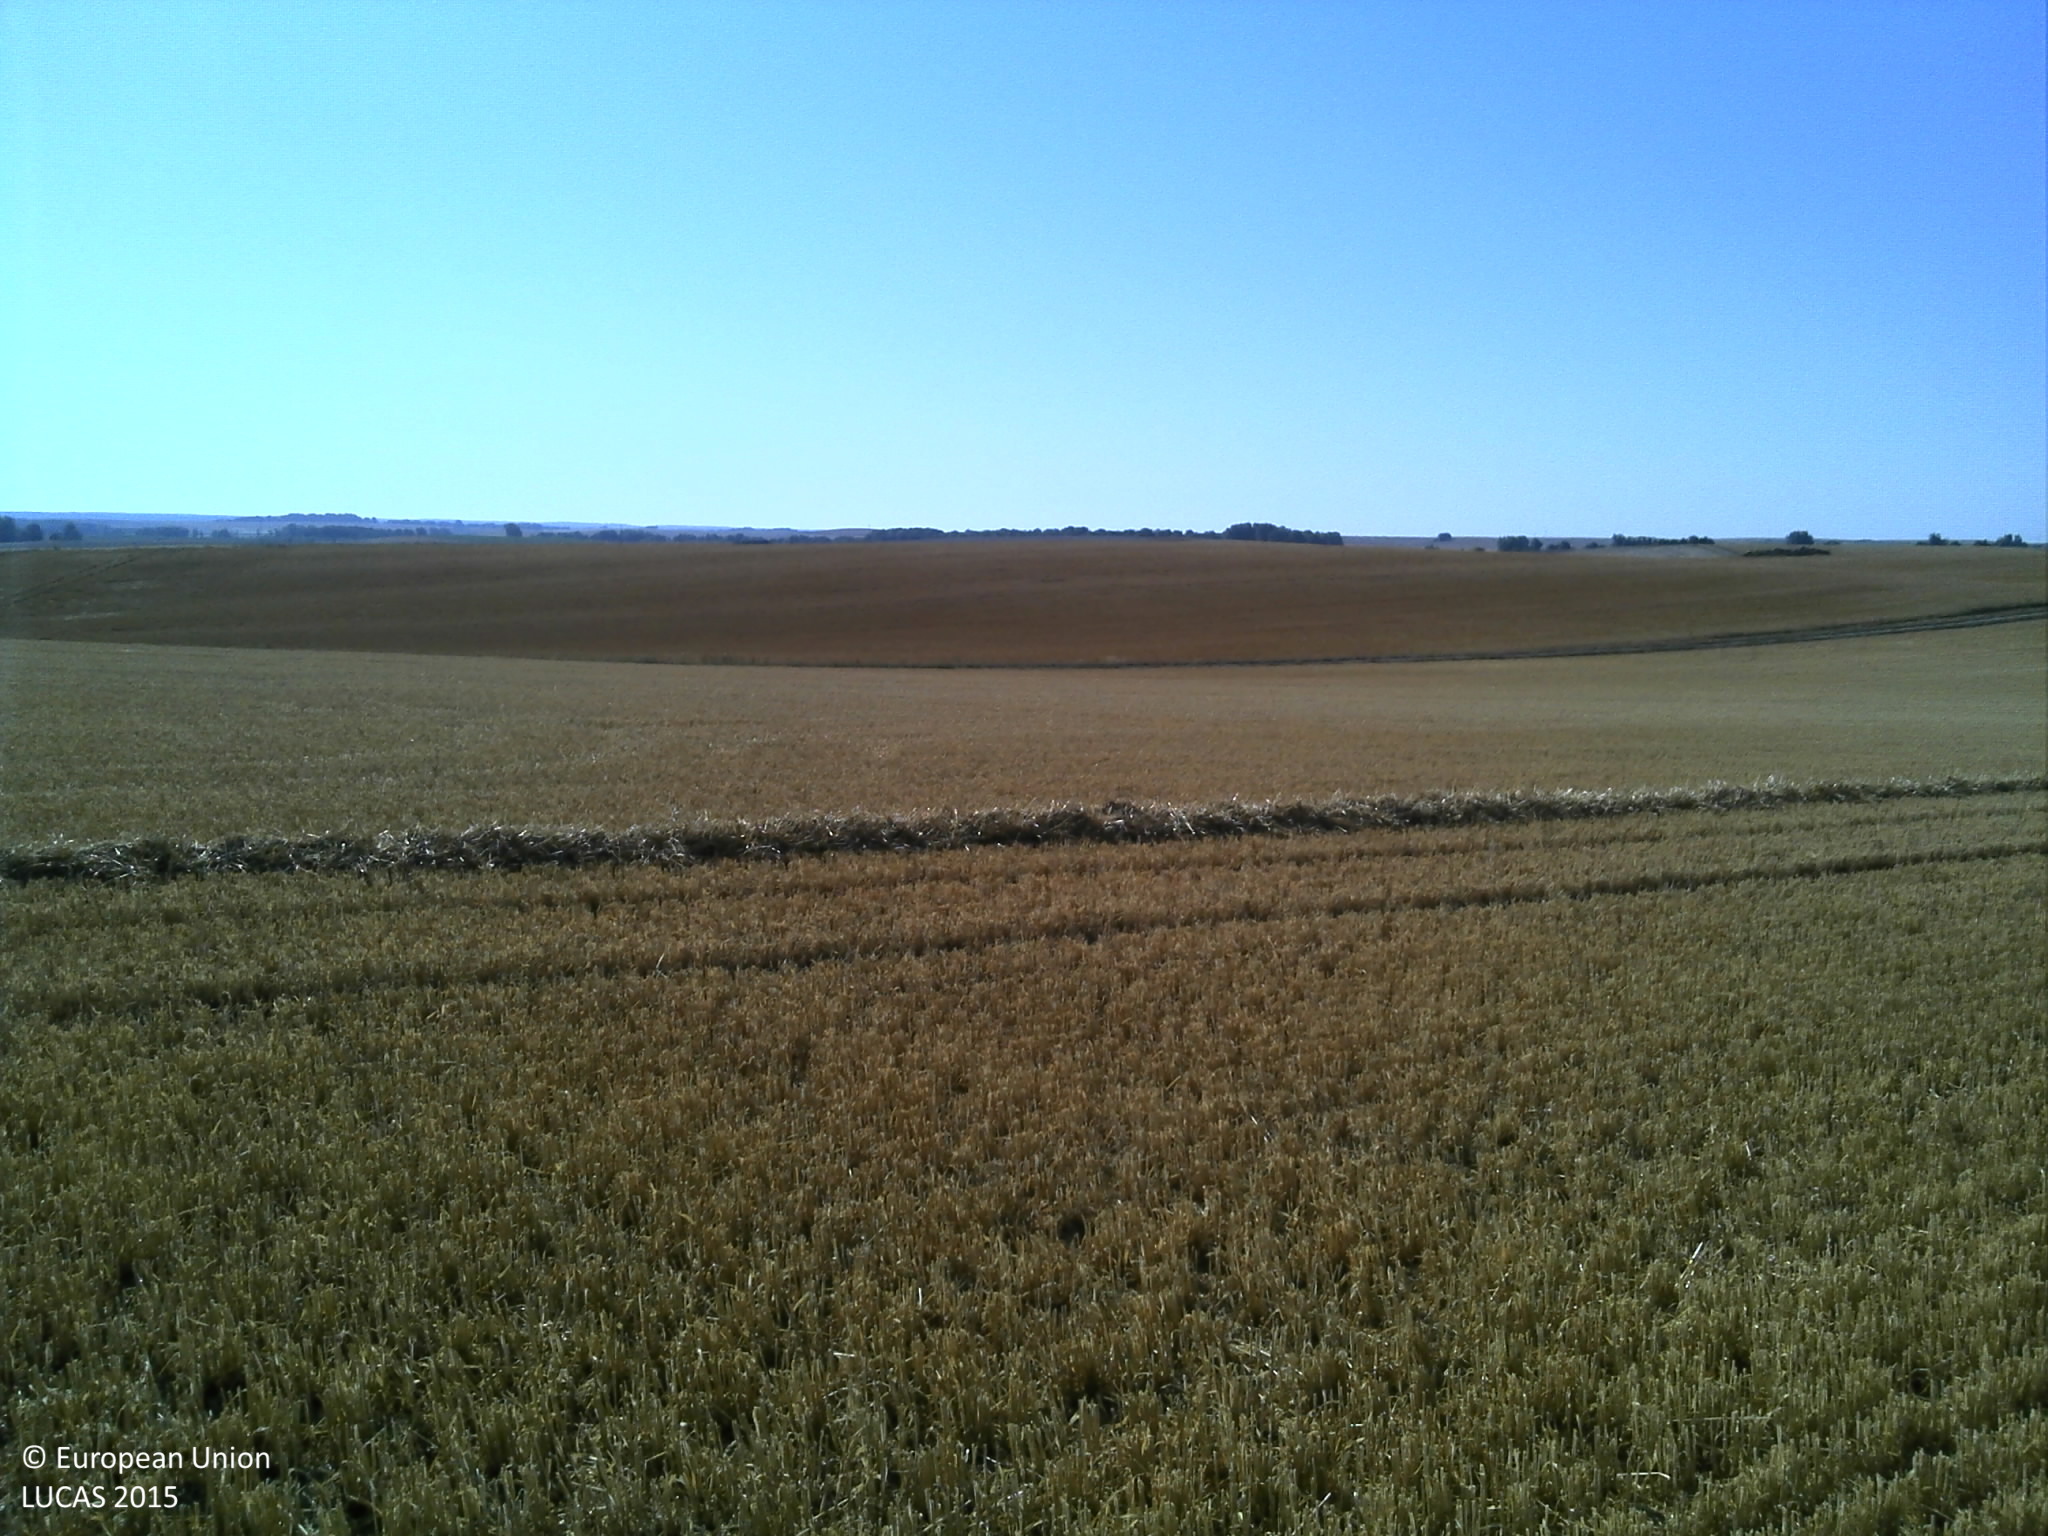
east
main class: Cropland
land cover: Barley
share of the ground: > 75 %
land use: Agriculture (excluding fallow land and kitchen gardens)
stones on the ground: < 10 %
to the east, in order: Barley; Grass margins; Tracks; Grass margins; Common wheat; Grass margins; Tracks; Grass margins; Common wheat
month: August
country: FR
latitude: 49.1453
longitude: 4.7742
